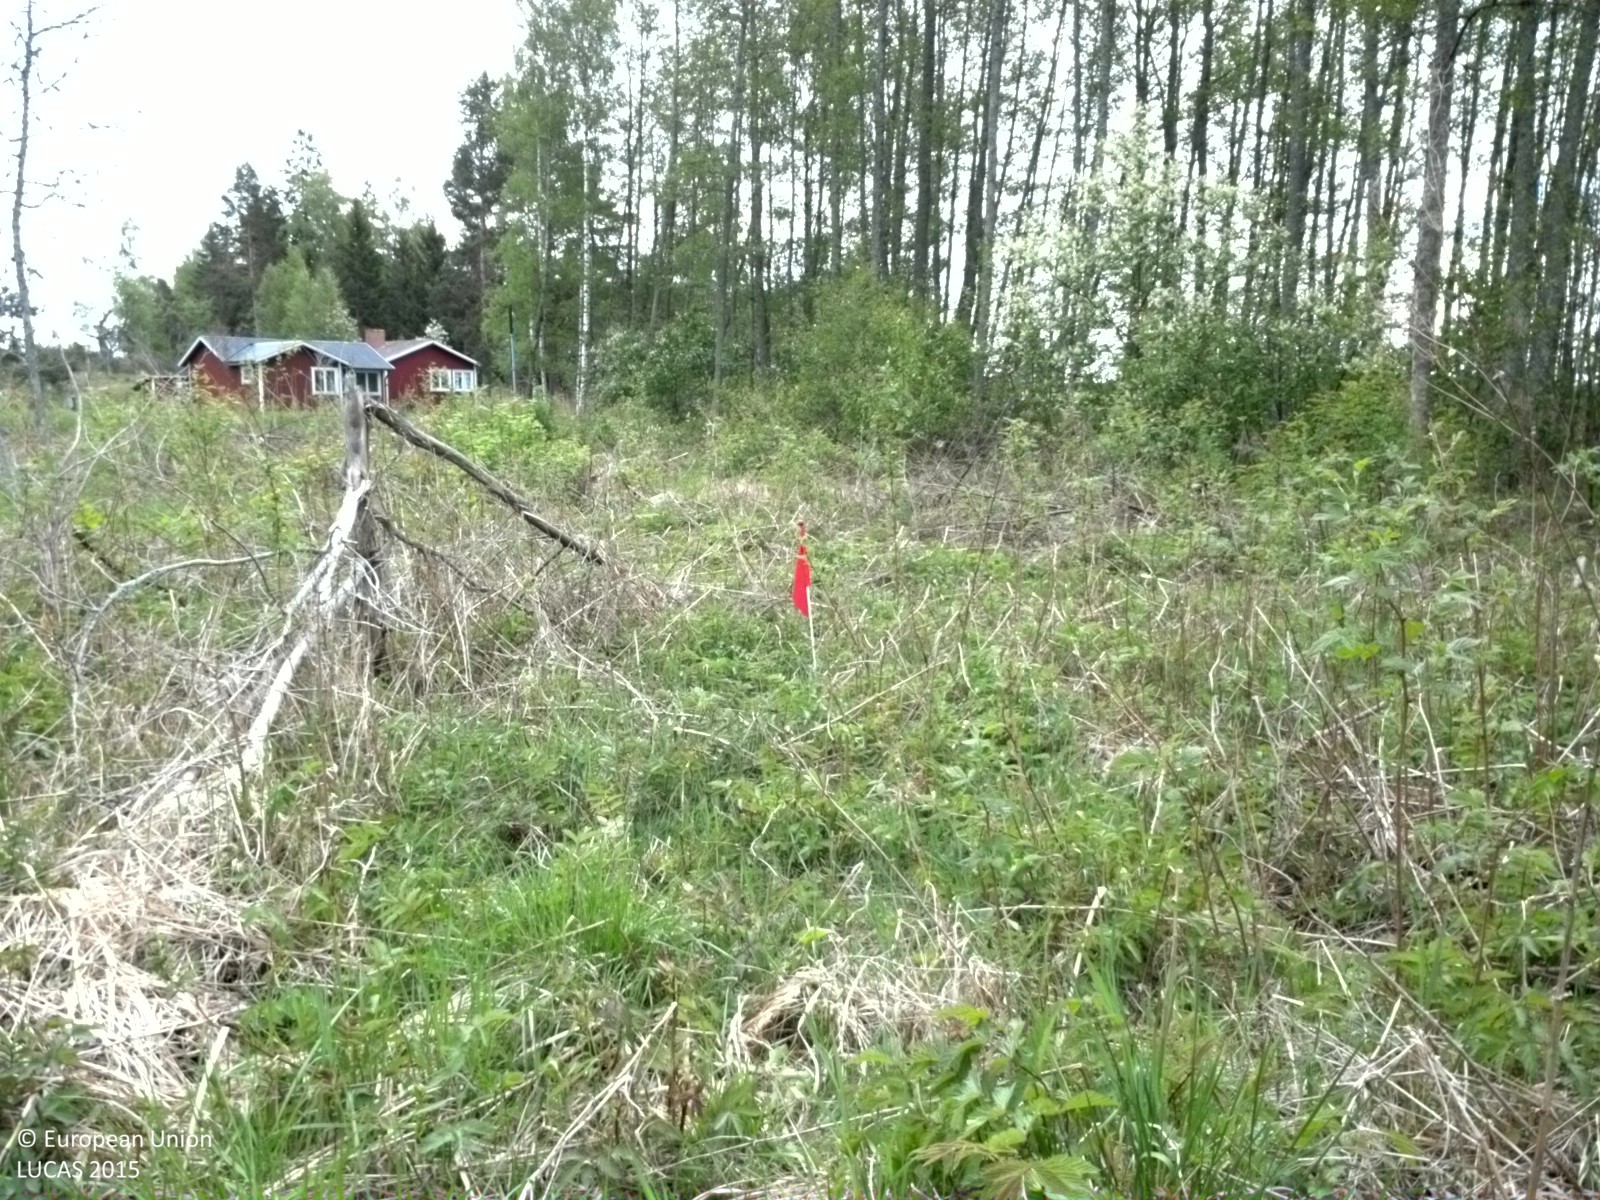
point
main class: Shrubland
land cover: Shrubland with sparse tree cover
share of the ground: 50 - 75 %
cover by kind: shrubs 65 %, herbaceous plants 30 %, broadleaved forest trees 5 %
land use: Forestry
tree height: < 5 m
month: May
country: SE
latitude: 60.3411
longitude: 18.4927
